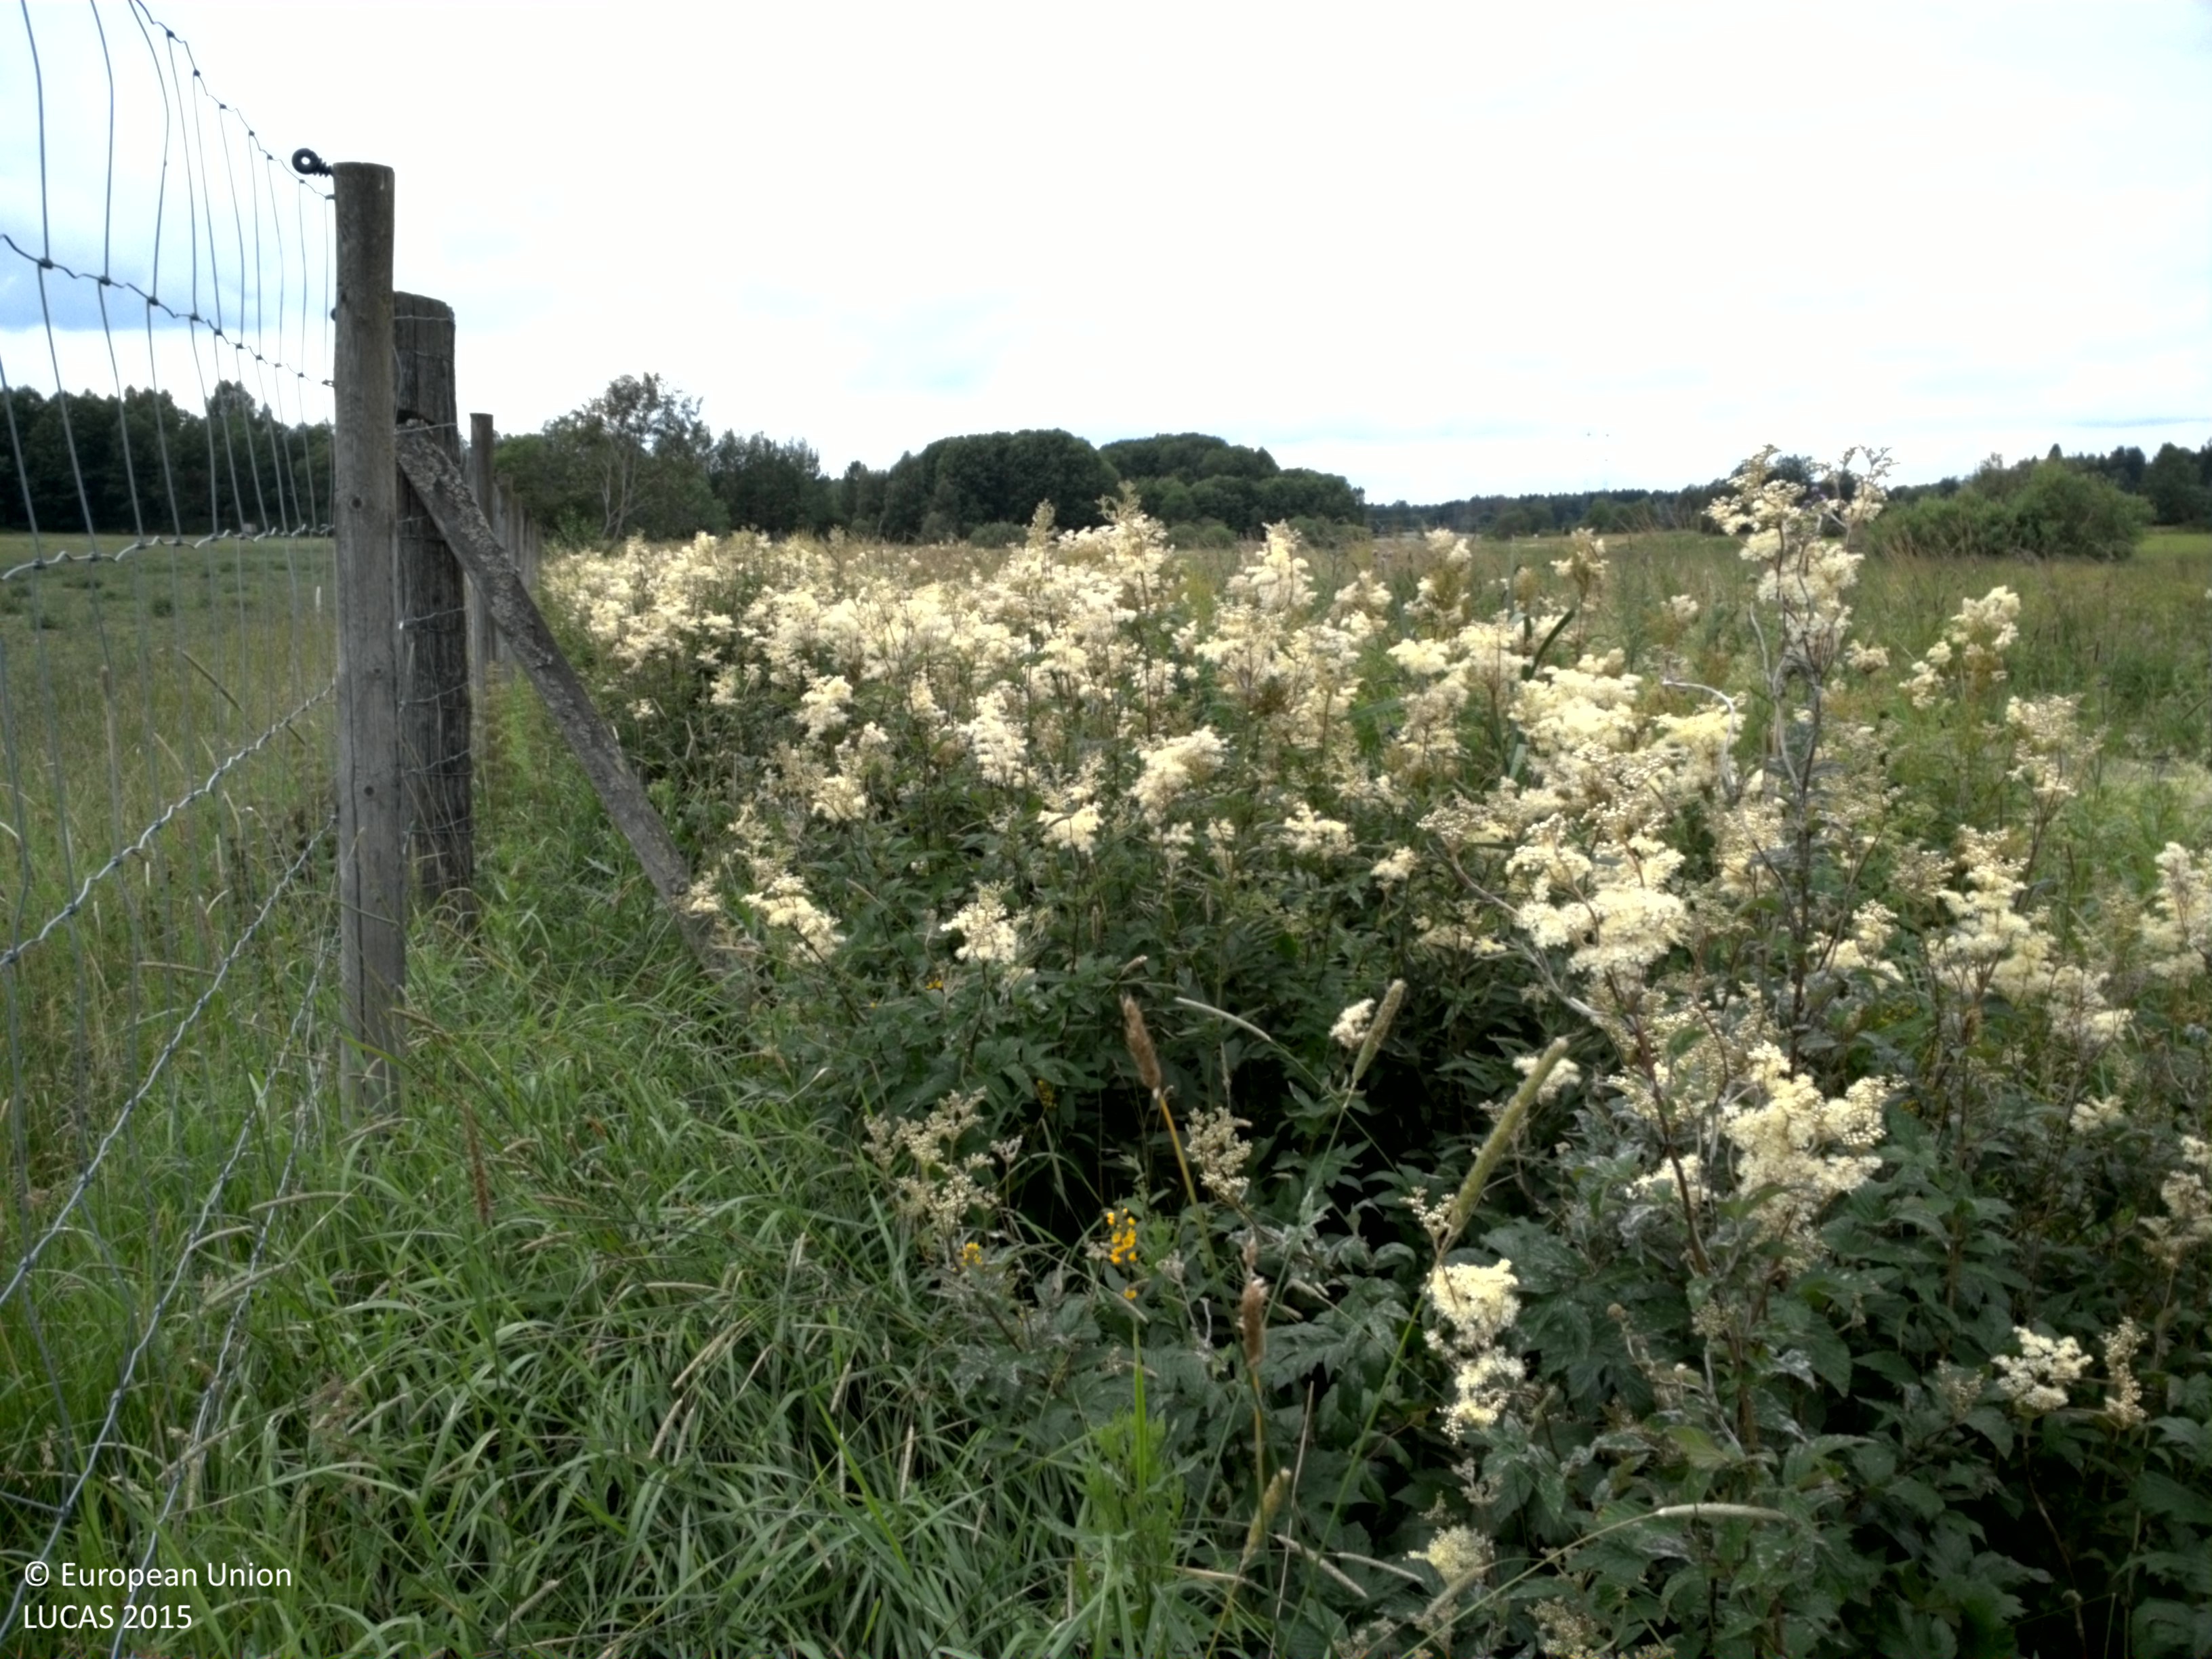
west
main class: Grassland
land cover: Spontaneously vegetated surfaces
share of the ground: 50 - 75 %
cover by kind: herbaceous plants 60 %, unconsolidated bare surface 40 %
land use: Agriculture (excluding fallow land and kitchen gardens)
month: July
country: SE
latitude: 59.7571
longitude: 18.5609
